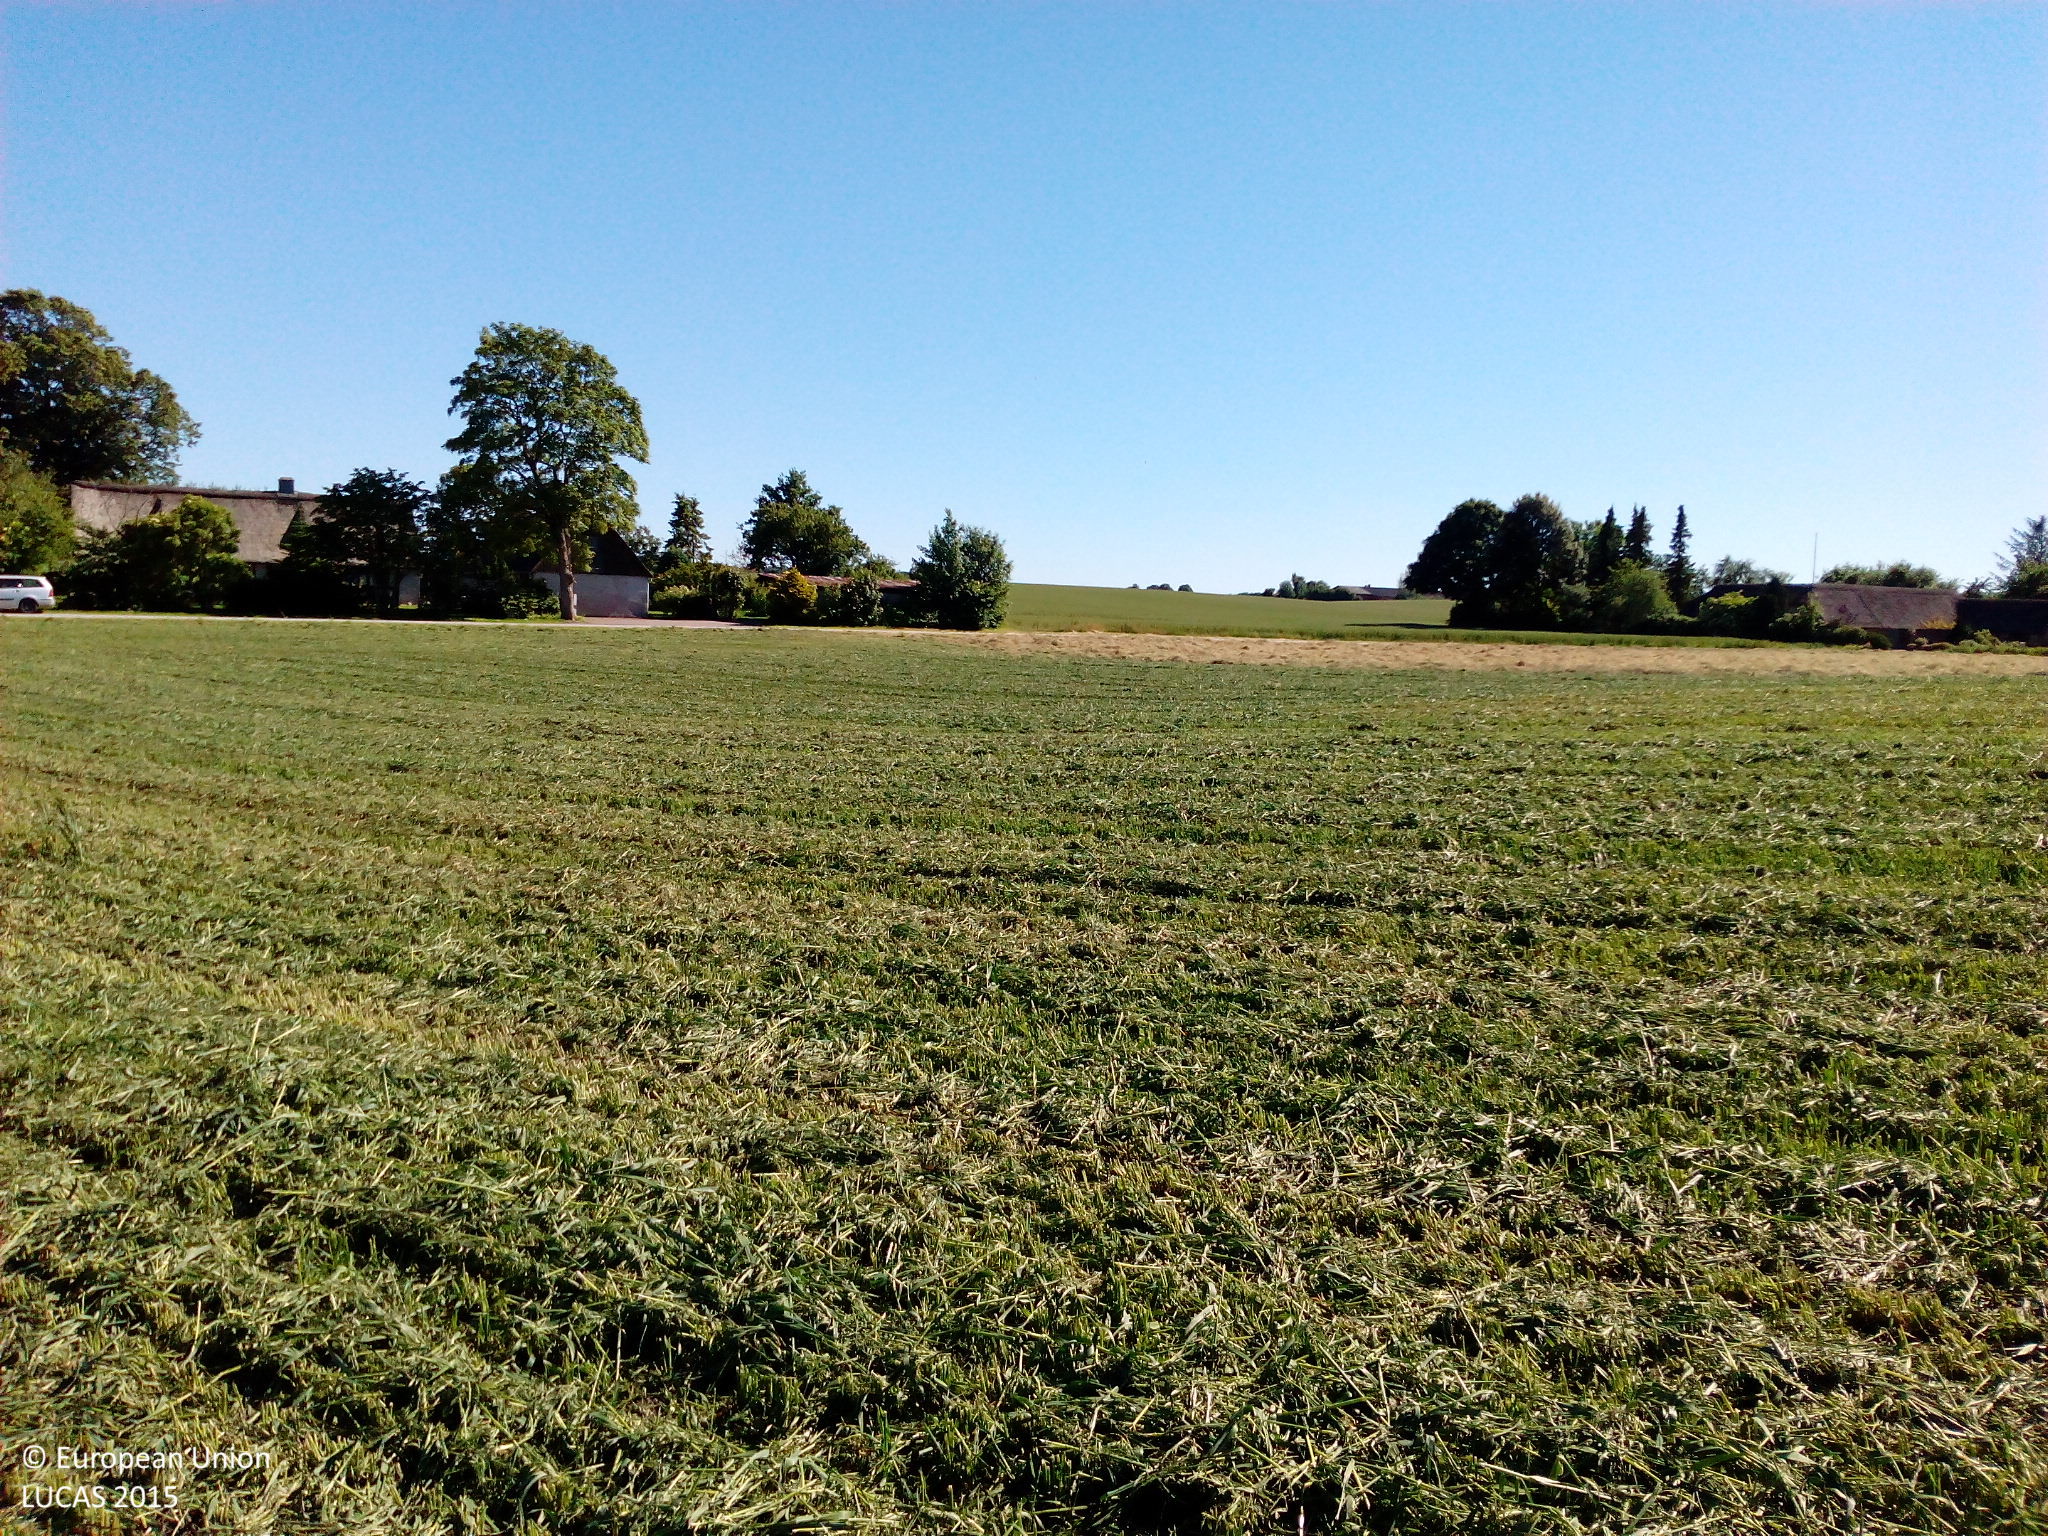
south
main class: Cropland
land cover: Mixed cereals for fodder
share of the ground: 50 - 75 %
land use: Agriculture (excluding fallow land and kitchen gardens)
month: July
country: DK
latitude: 56.4727
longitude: 10.8269
